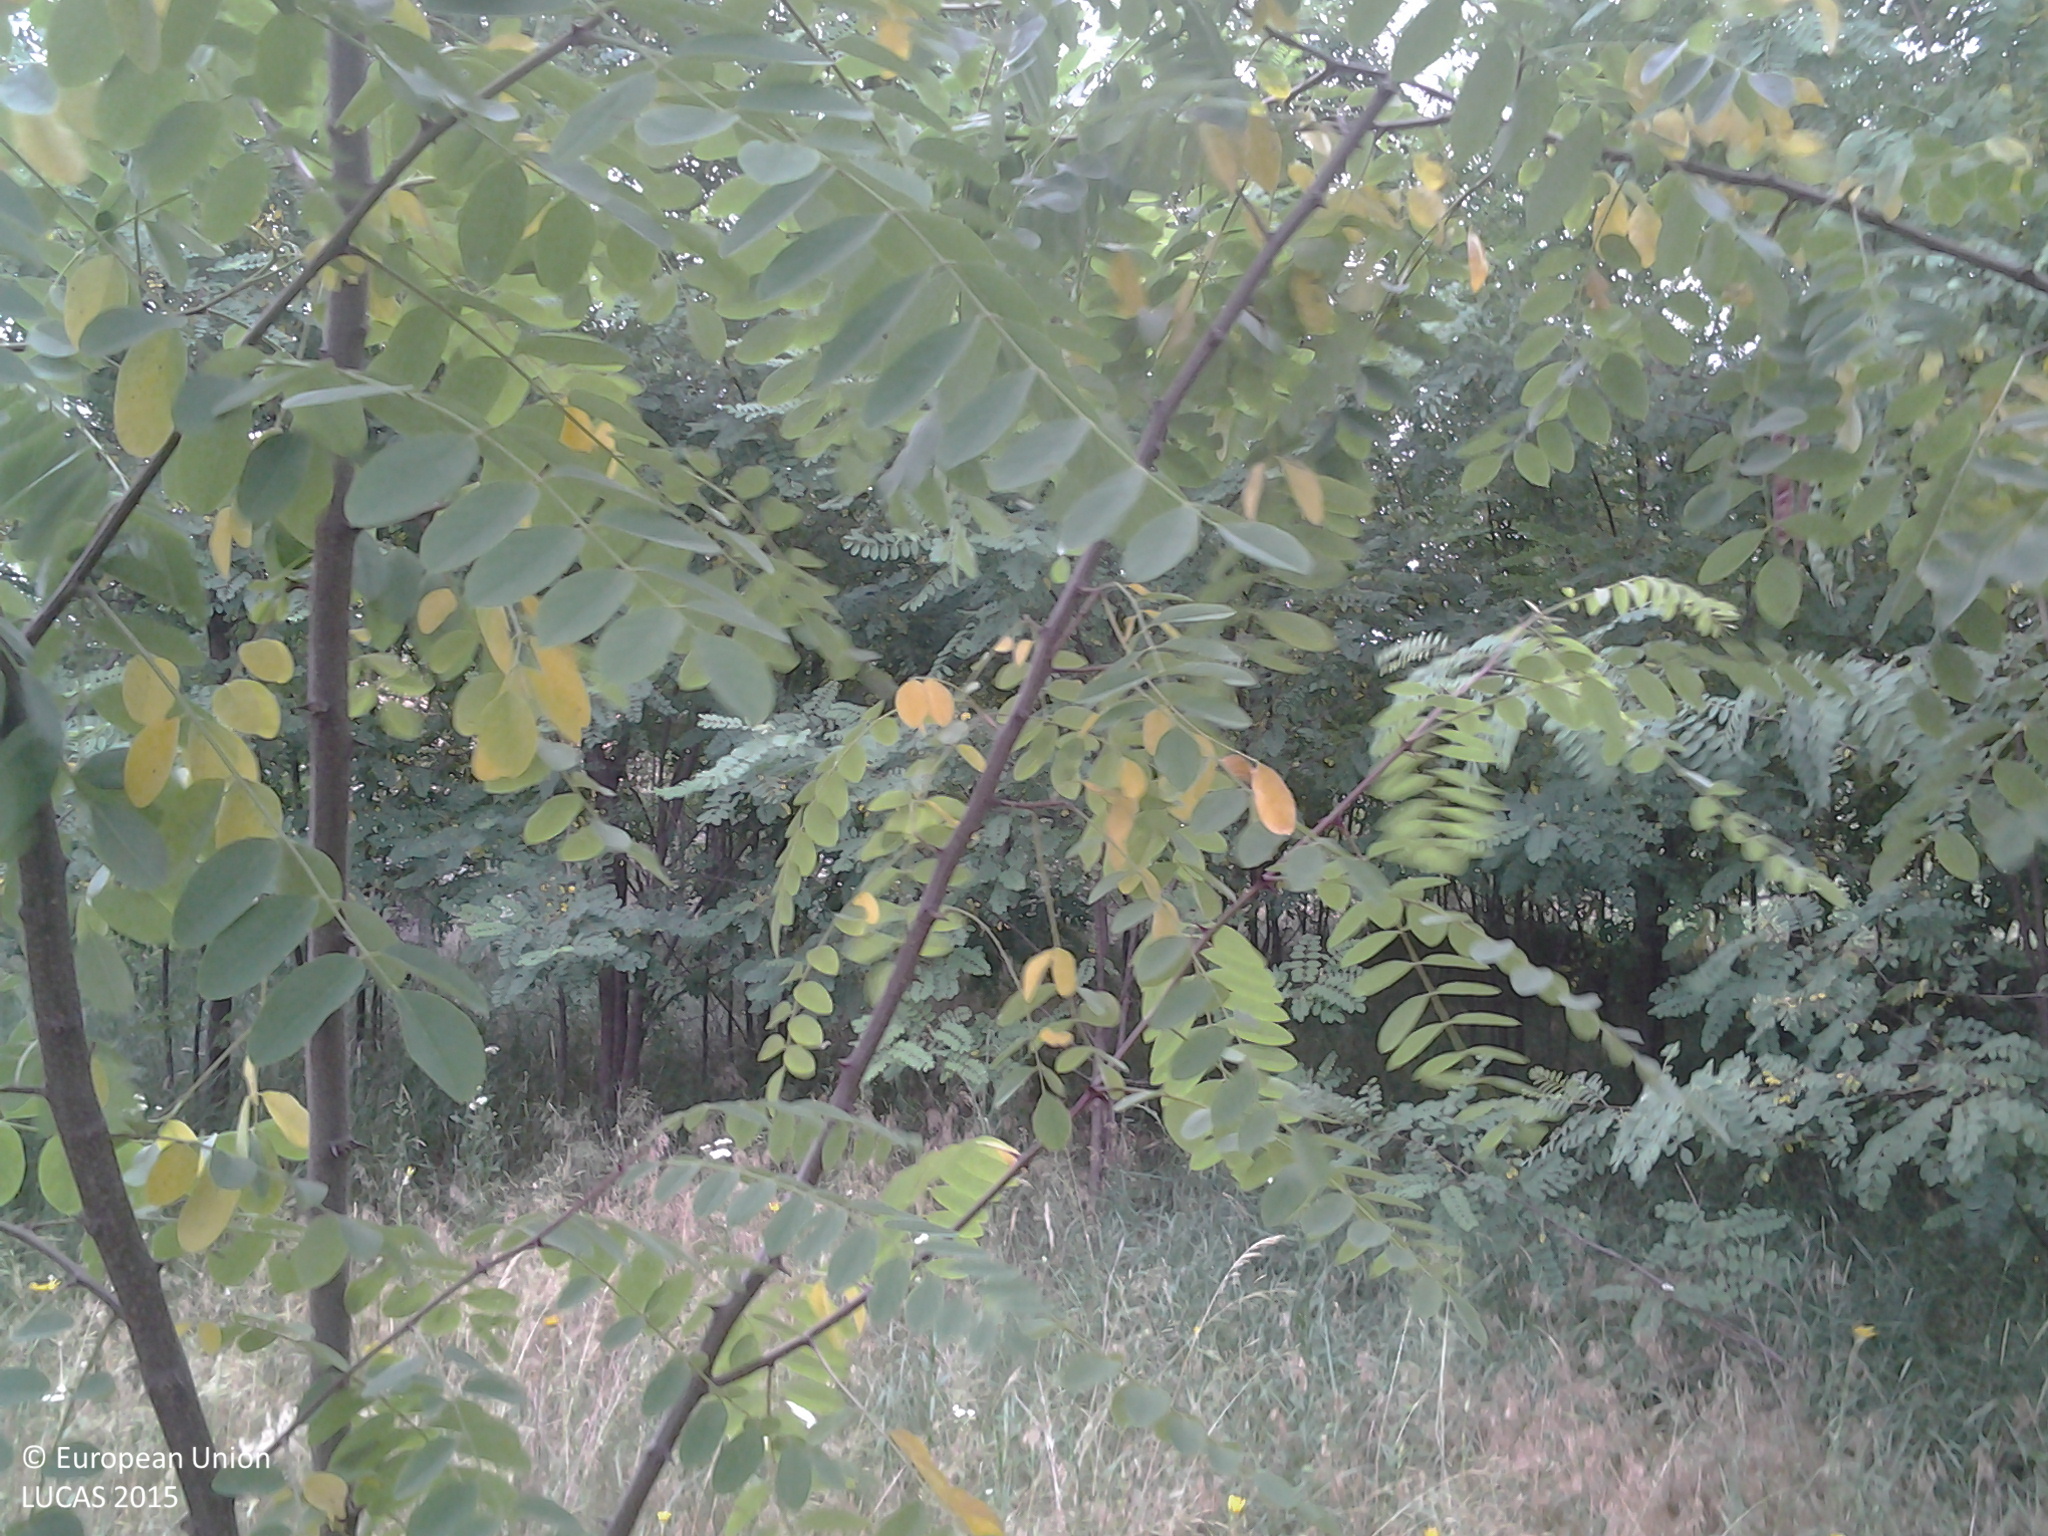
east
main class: Woodland
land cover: Broadleaved woodland
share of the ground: 10 - 25 %
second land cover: Grassland without tree/shrub cover
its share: > 75 %
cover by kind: herbaceous plants 80 %, broadleaved forest trees 20 %
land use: Forestry
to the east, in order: Broadleaved woodland; Grassland without tree/shrub cover; Artificial constructions in urban areas; Broadleaved woodland; Grassland without tree/shrub cover
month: June
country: HU
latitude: 46.9272
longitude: 19.6737
